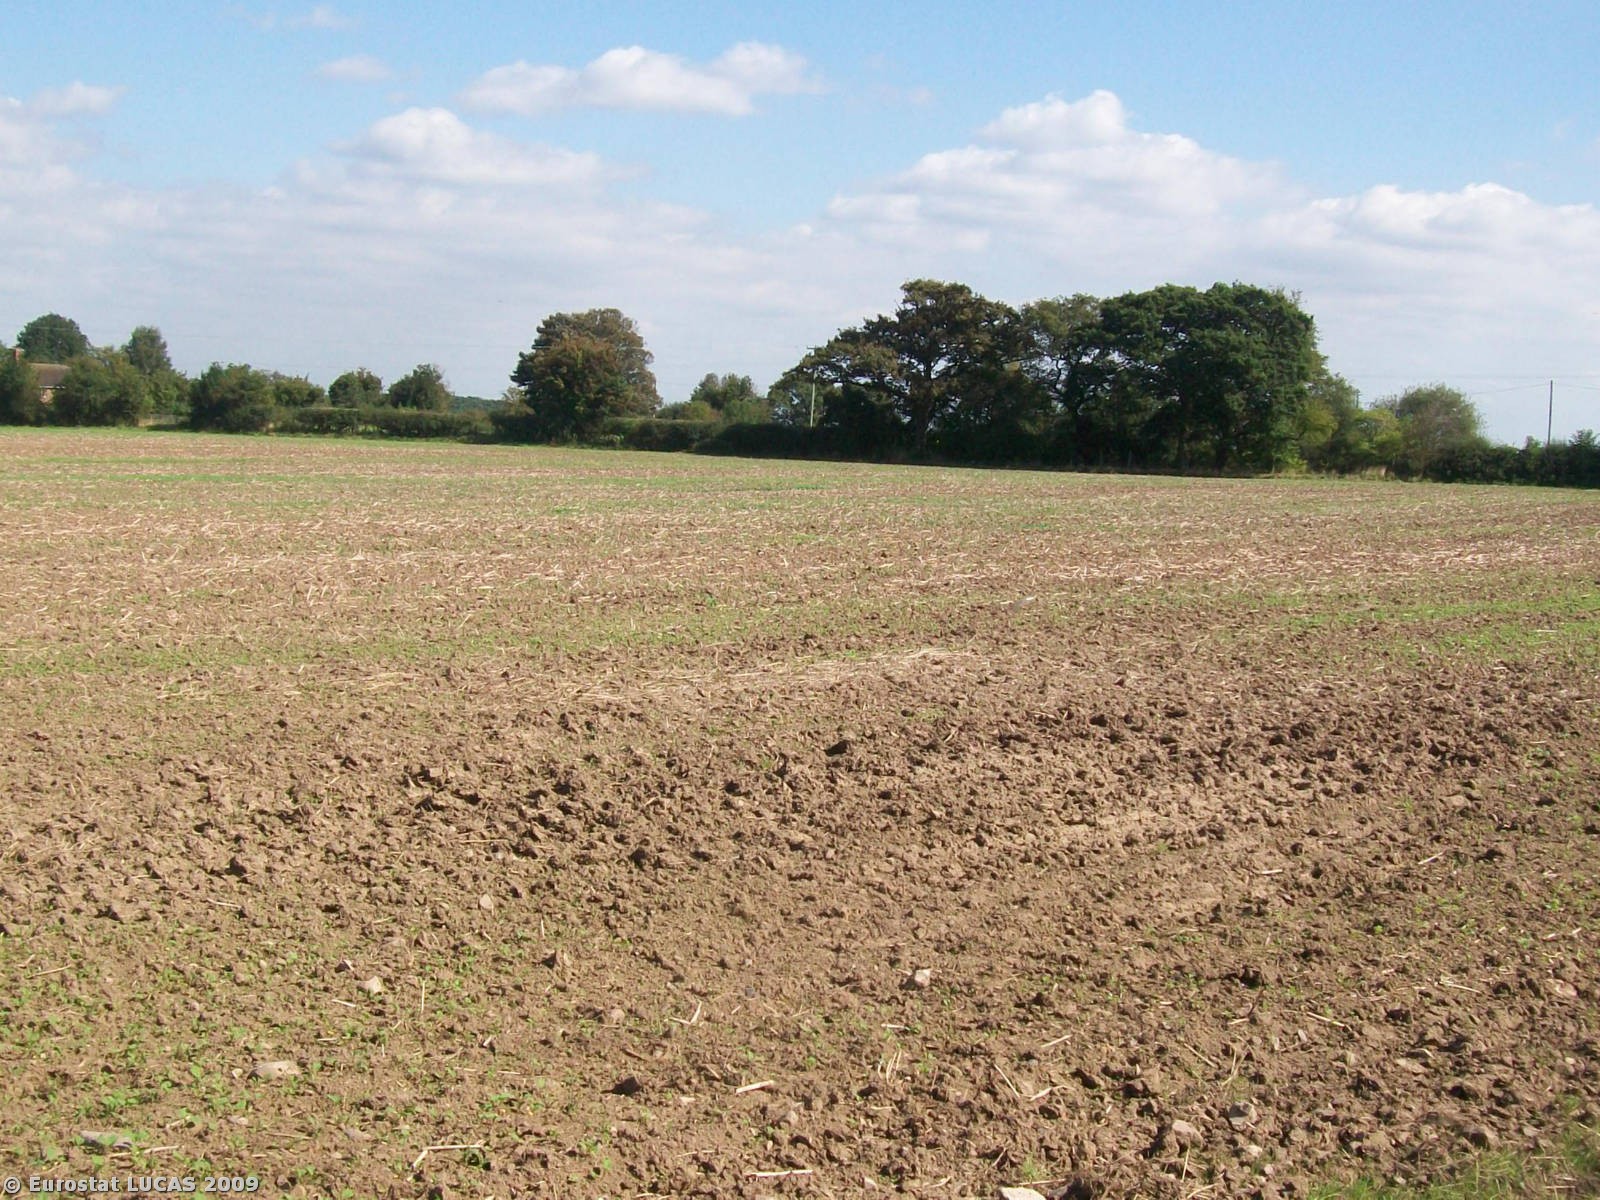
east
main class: Cropland
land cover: Rape and turnip rape
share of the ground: > 75 %
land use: Agriculture (excluding fallow land and kitchen gardens)
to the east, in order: Rape and turnip rape; Electric lines; Managed hedges; Artificial constructions in urban areas; Rape and turnip rape
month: September
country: GB
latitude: 52.8274
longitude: -2.6391
